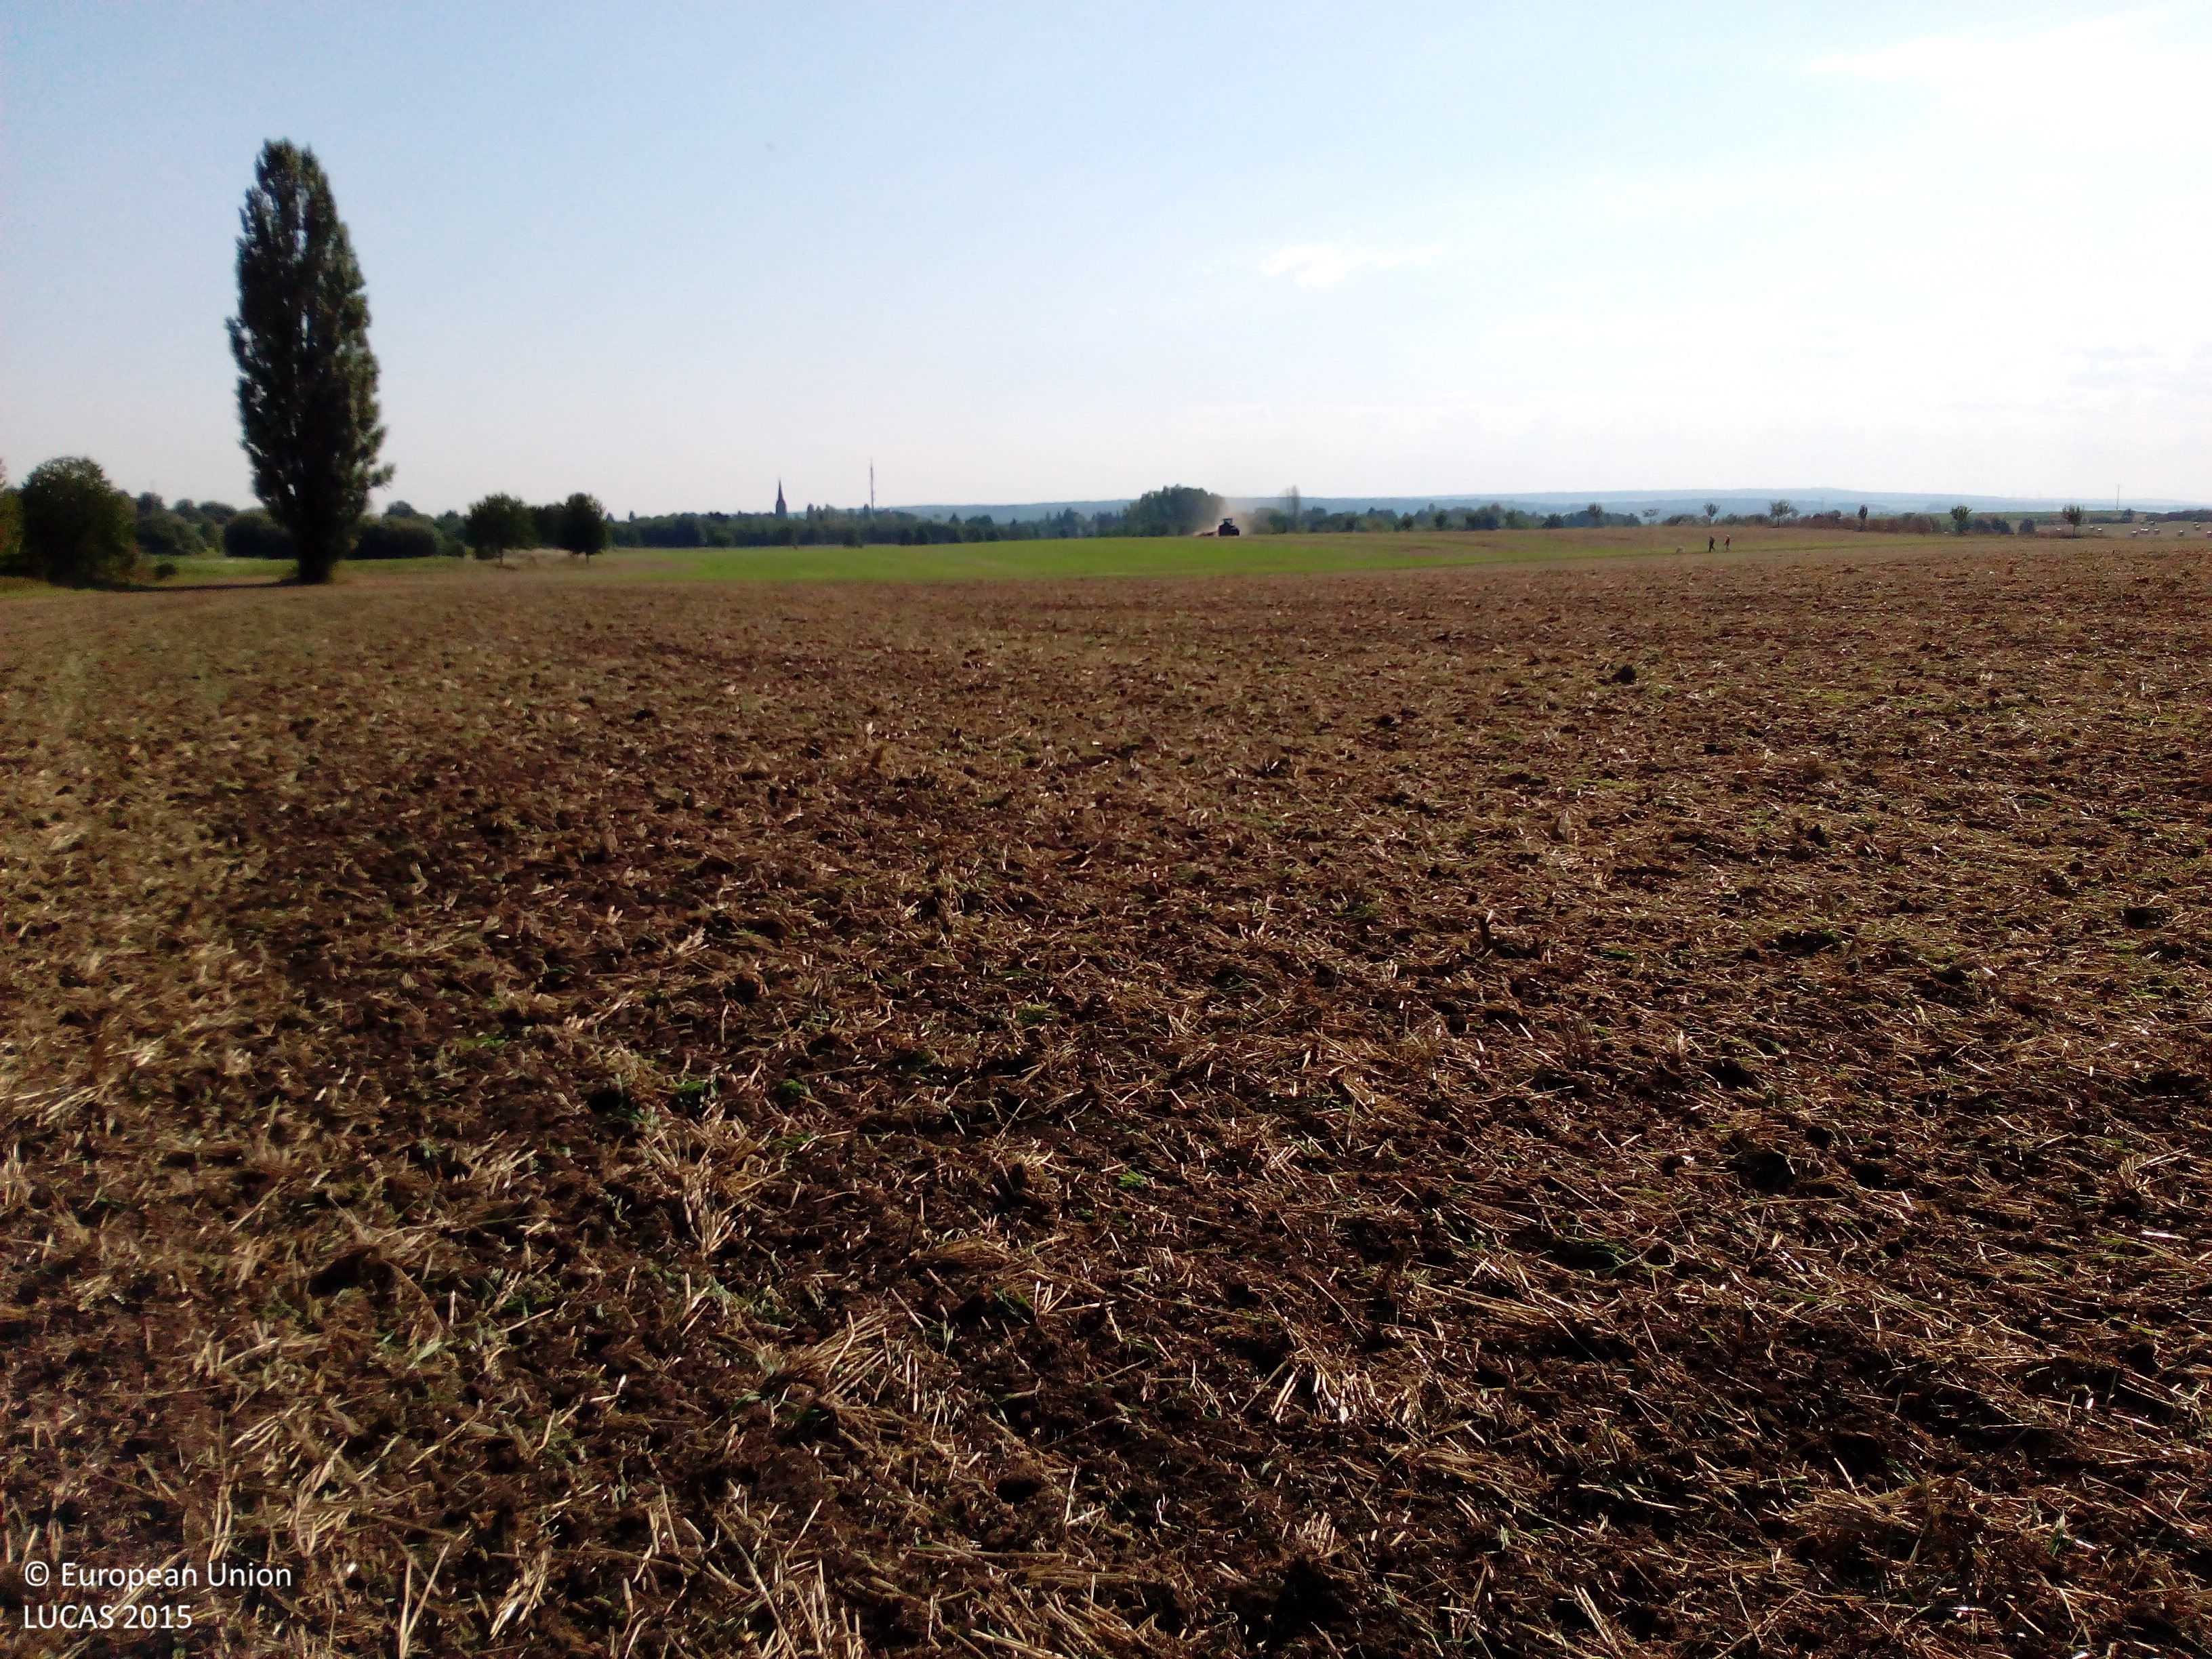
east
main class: Cropland
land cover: Barley
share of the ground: < 10 %
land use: Agriculture (excluding fallow land and kitchen gardens)
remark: Harvested field
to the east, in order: Barley; Grass margins; Tracks; Grass margins; Barley
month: August
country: DE
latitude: 50.9534
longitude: 10.9535
